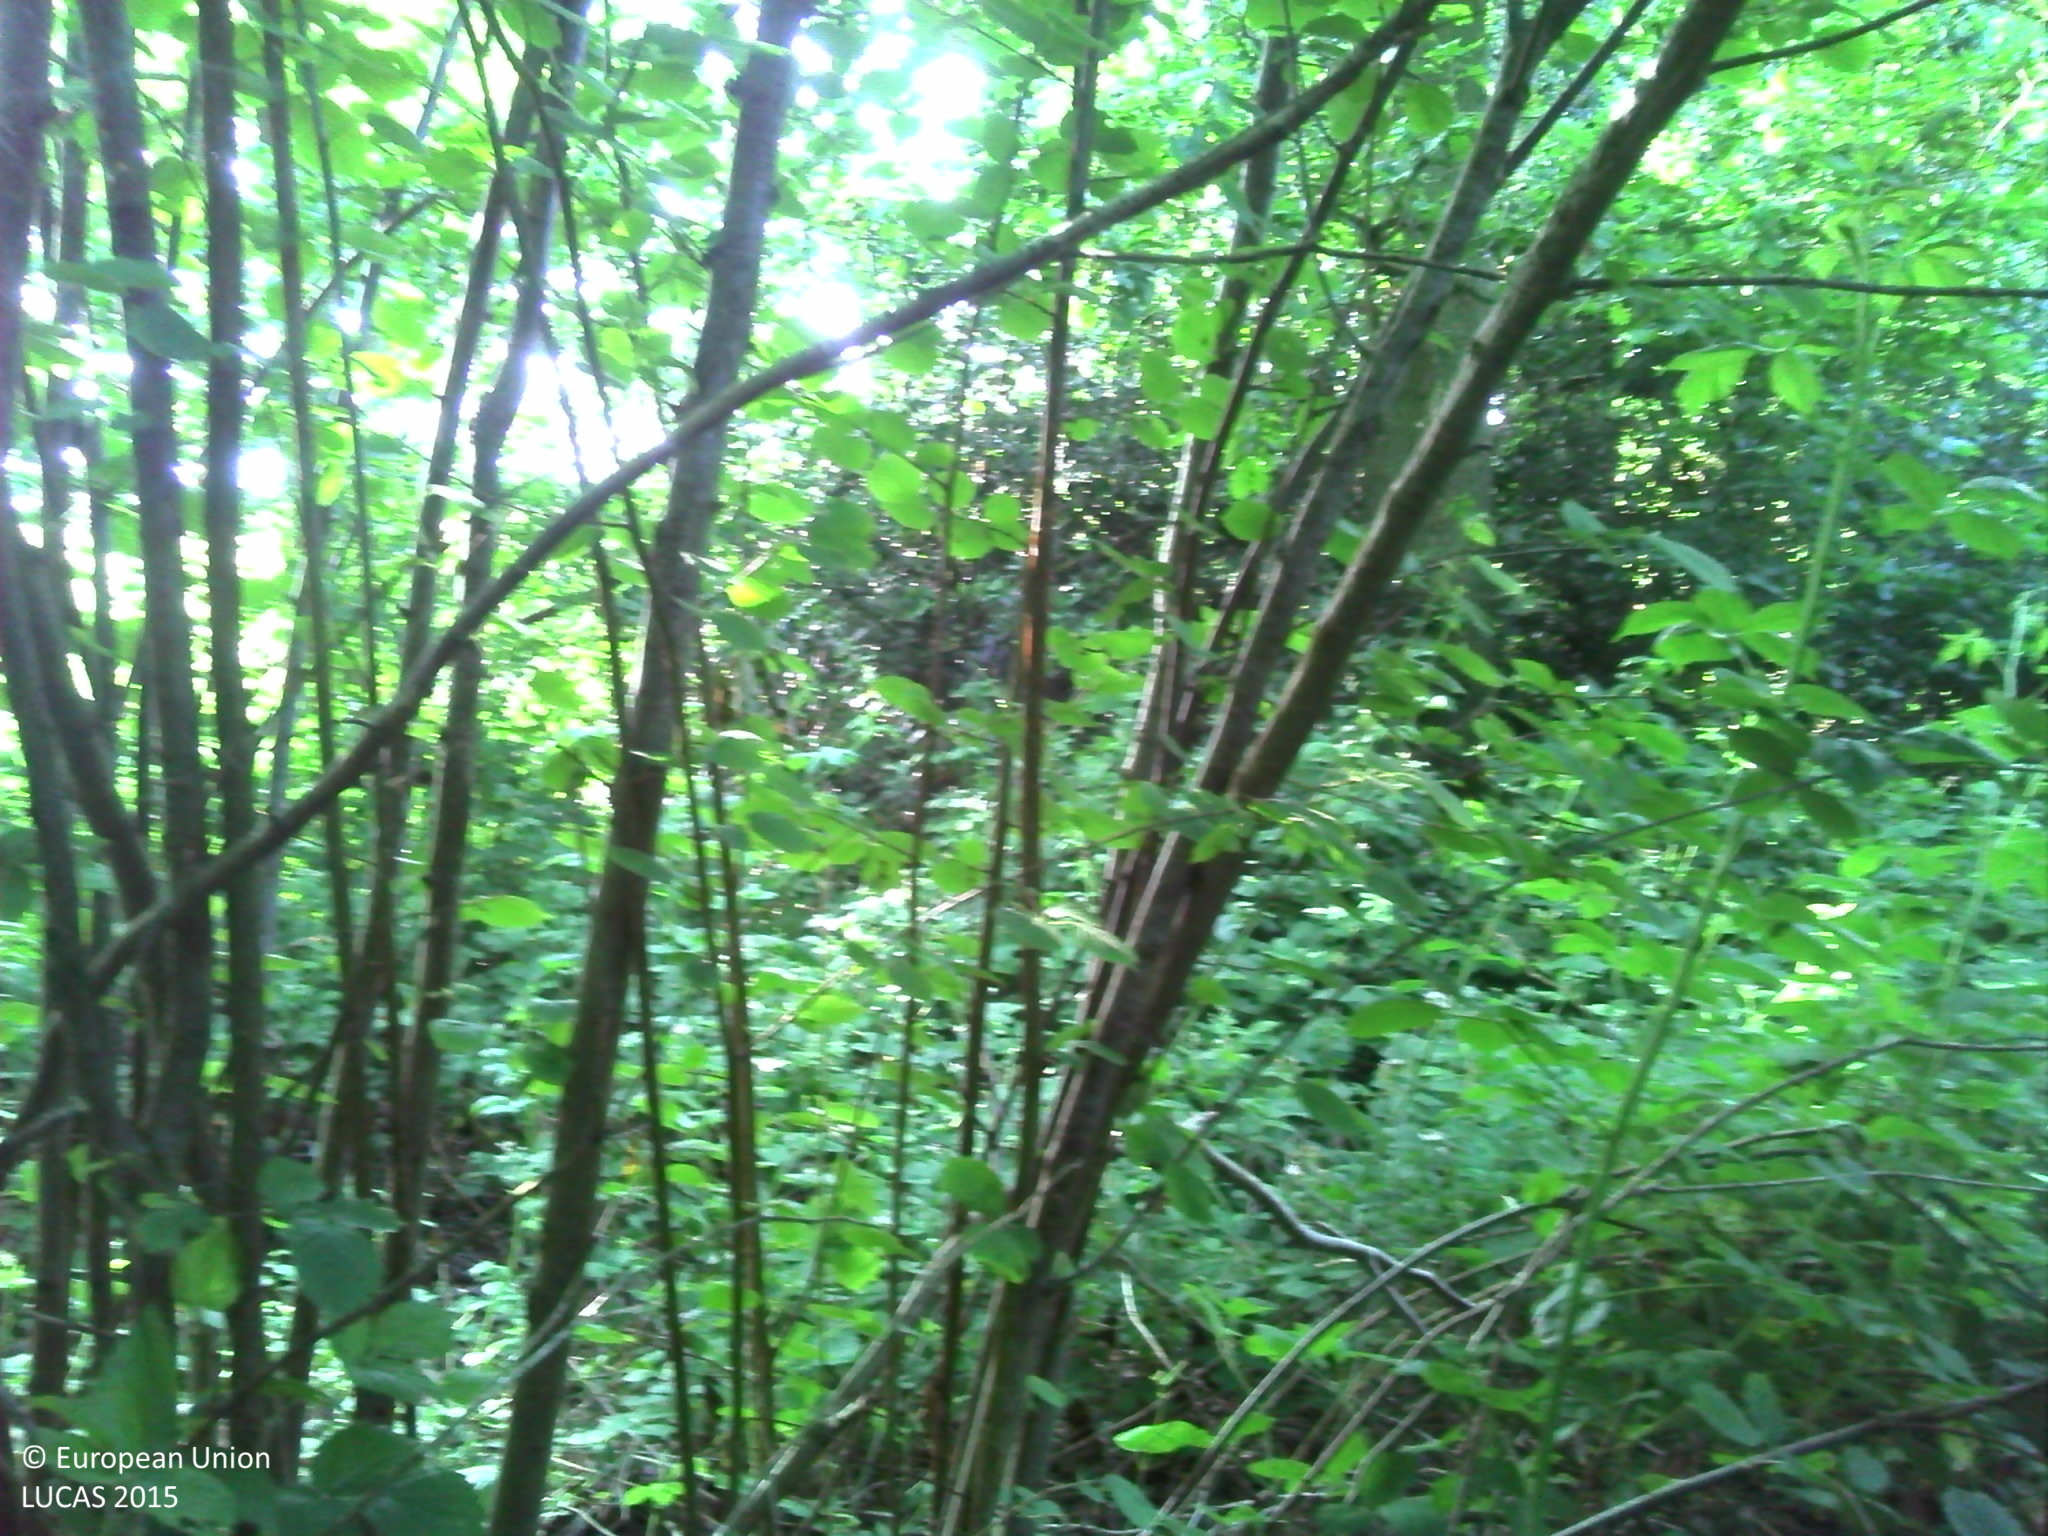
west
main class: Woodland
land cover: Broadleaved woodland
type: mesophytic deciduous forest
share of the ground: > 75 %
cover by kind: broadleaved forest trees 80 %, herbaceous plants 10 %, consolidated bare surface 10 %
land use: Forestry
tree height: > 5 m
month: June
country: FR
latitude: 49.1622
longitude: 1.0510
